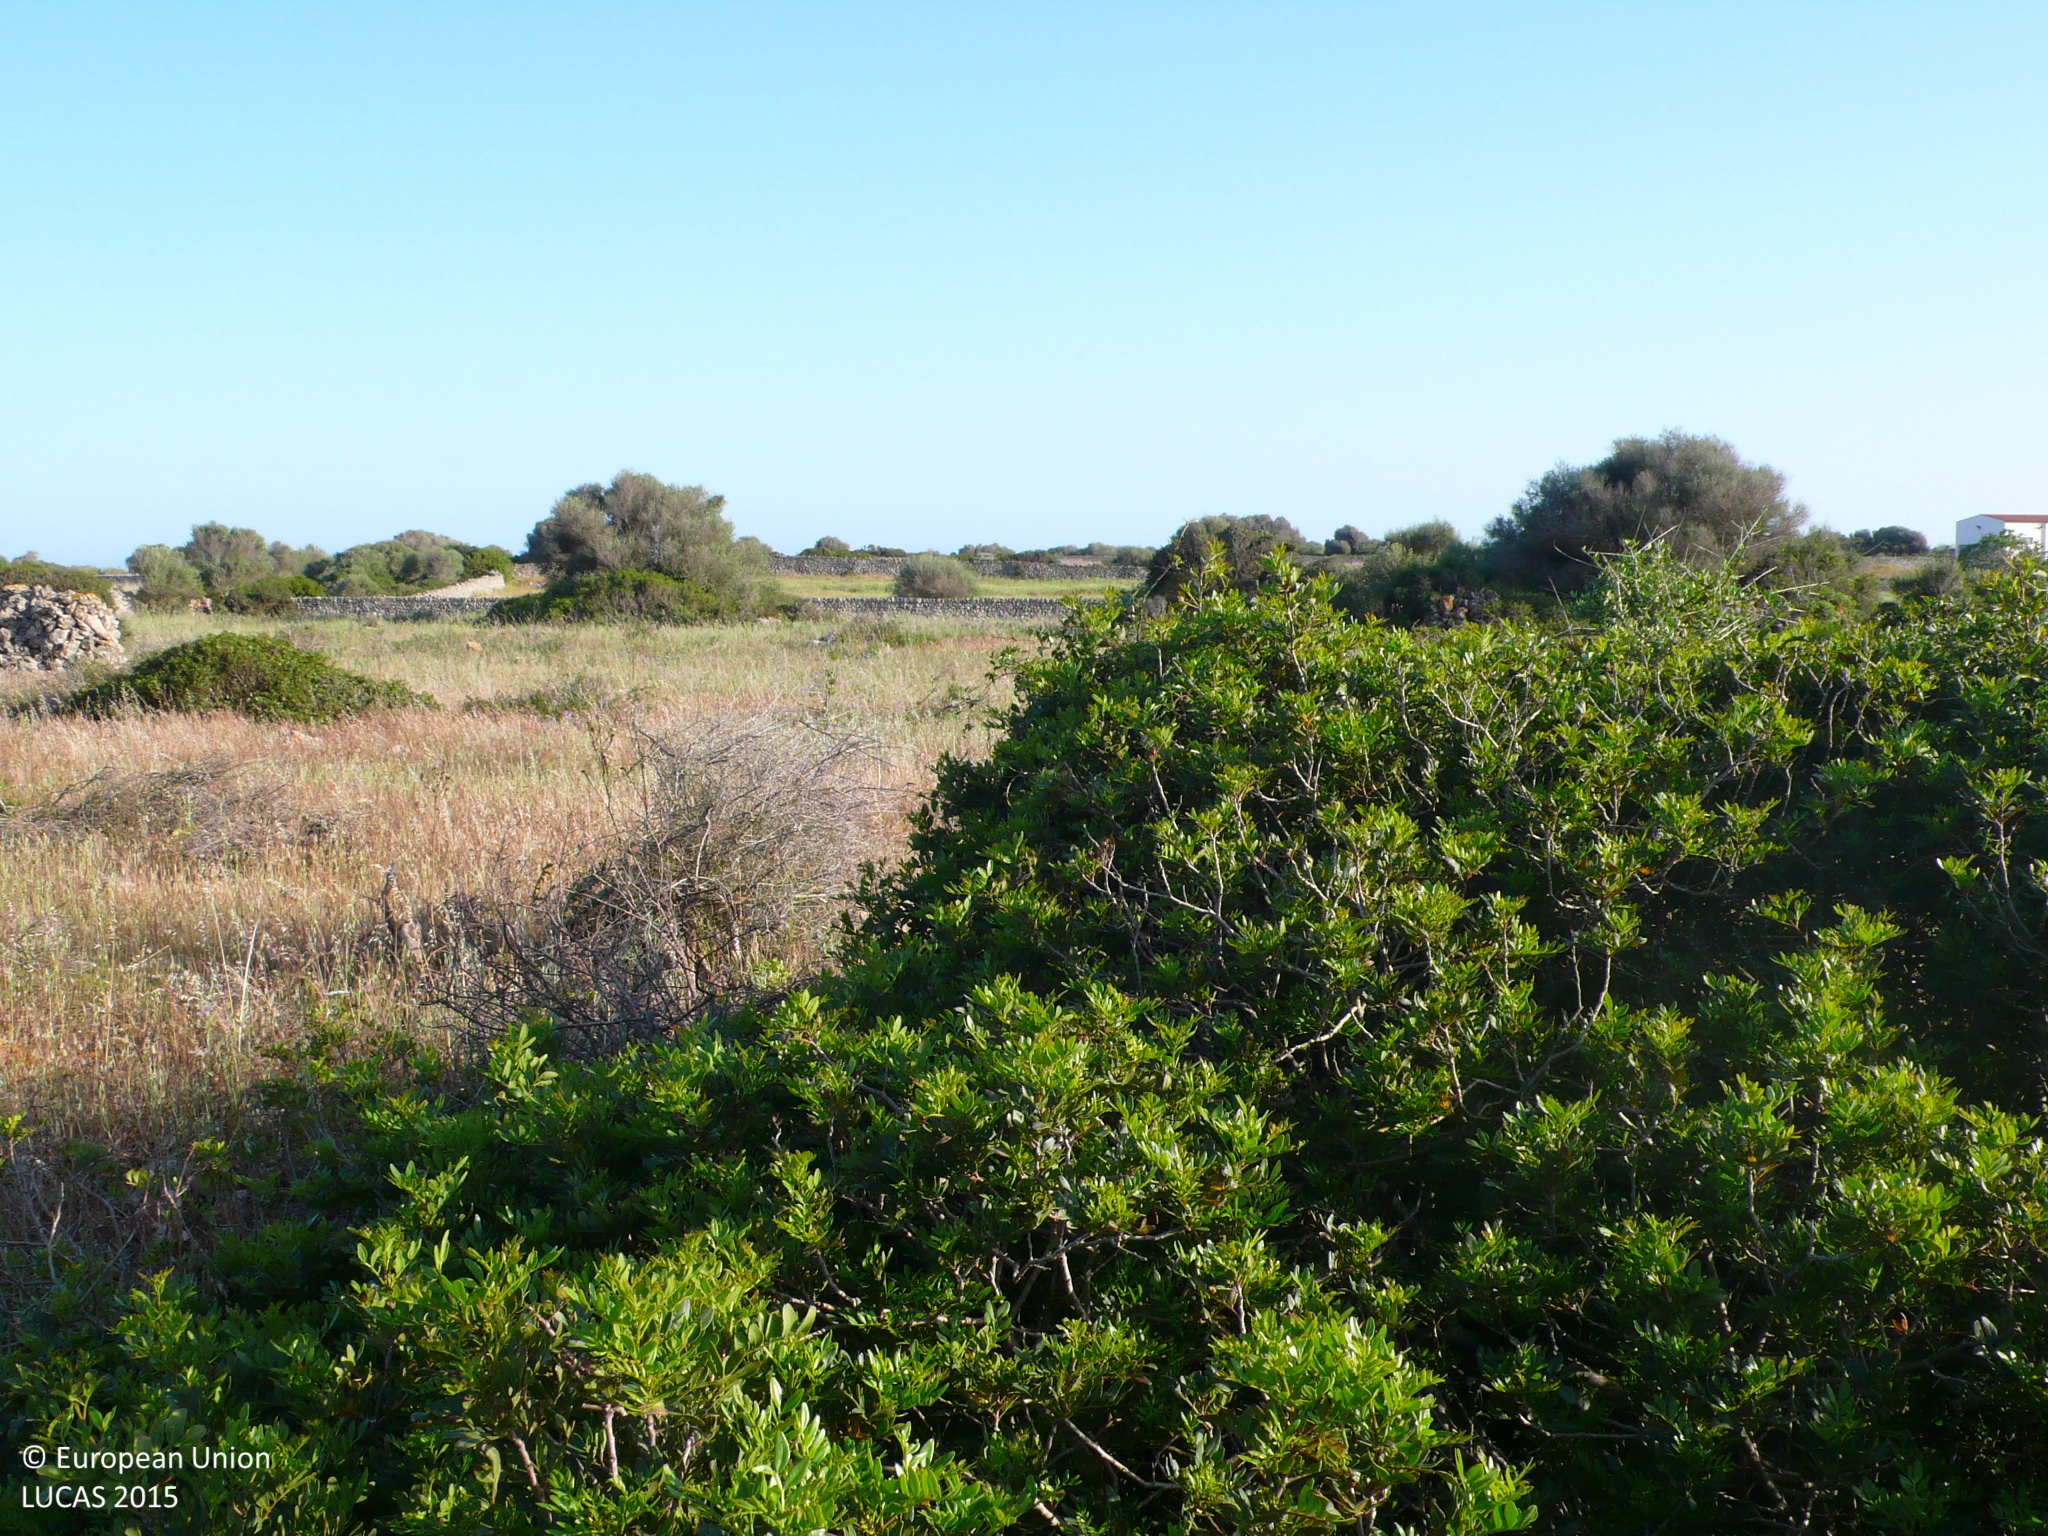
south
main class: Shrubland
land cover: Shrubland with sparse tree cover
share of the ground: 25 - 50 %
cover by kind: herbaceous plants 70 %, shrubs 25 %, broadleaved forest trees 5 %
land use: Semi-natural and natural areas not in use
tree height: < 5 m
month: May
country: ES
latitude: 39.8941
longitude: 4.1670
